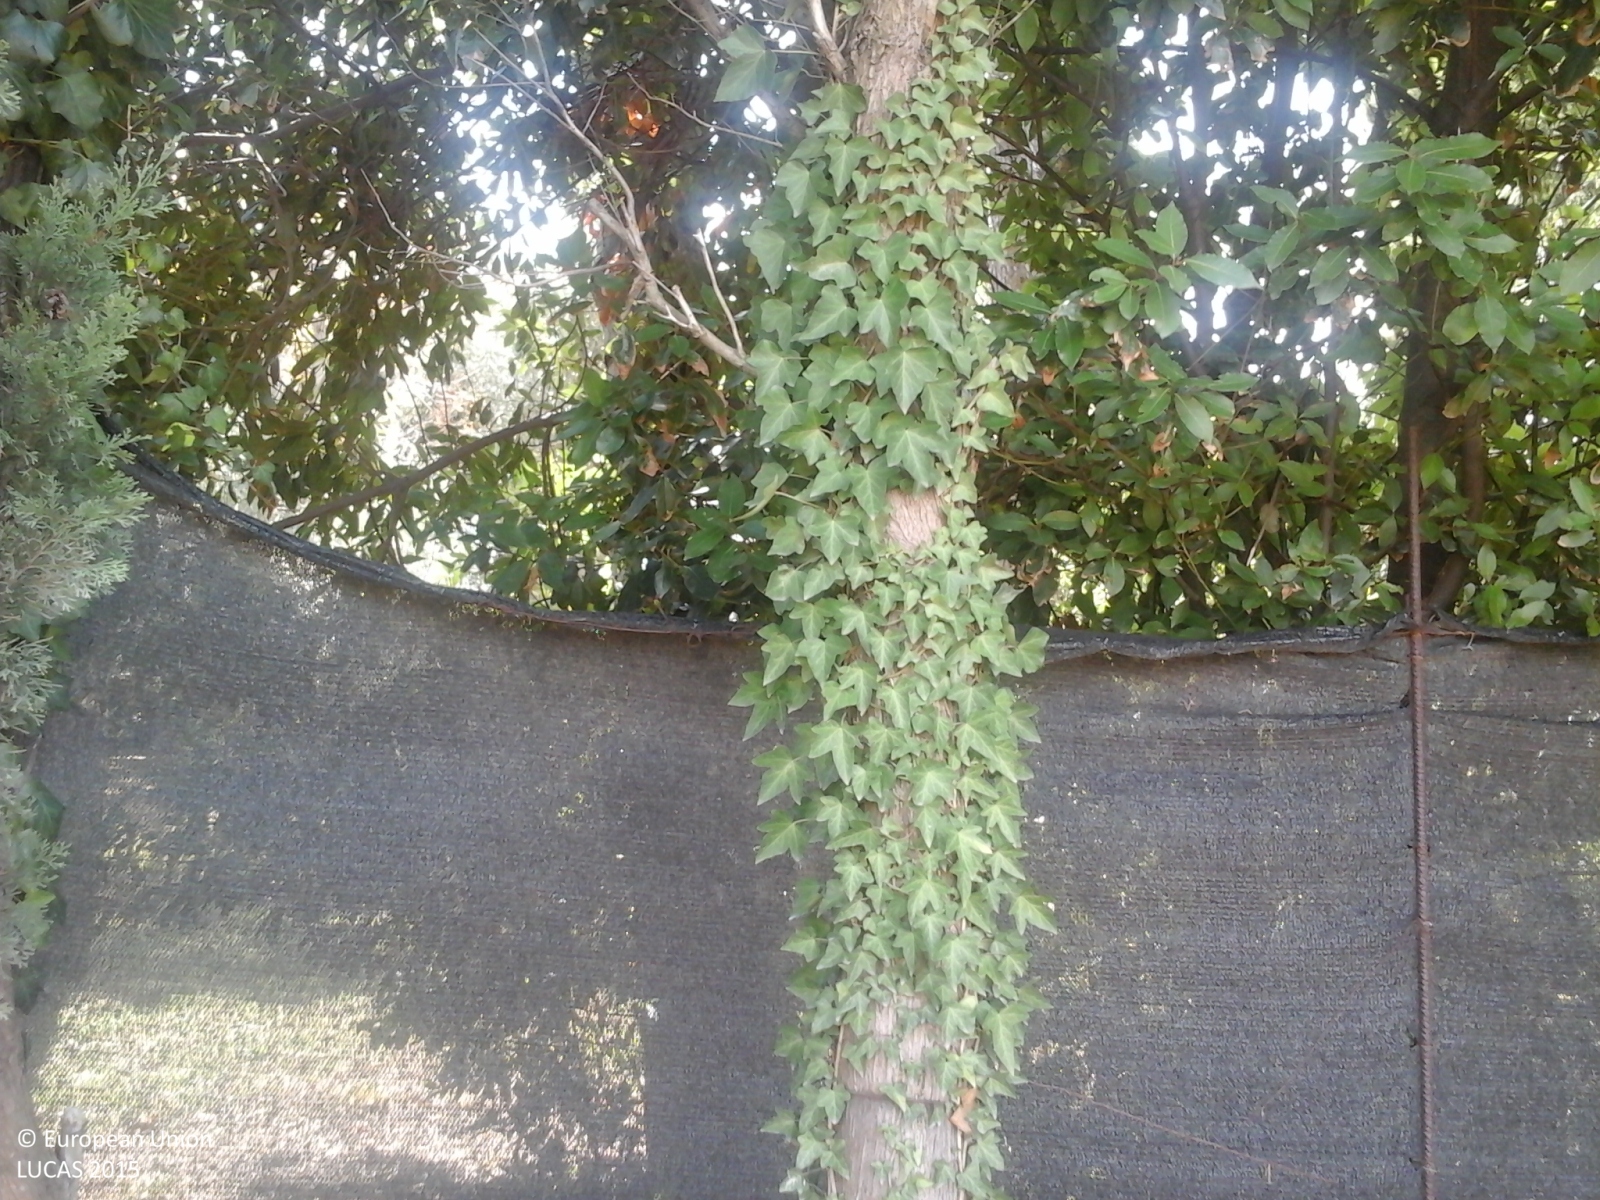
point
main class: Woodland
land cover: Broadleaved woodland
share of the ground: > 75 %
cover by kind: broadleaved forest trees 100 %
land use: Residential
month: September
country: IT
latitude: 43.9138
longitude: 12.8700
